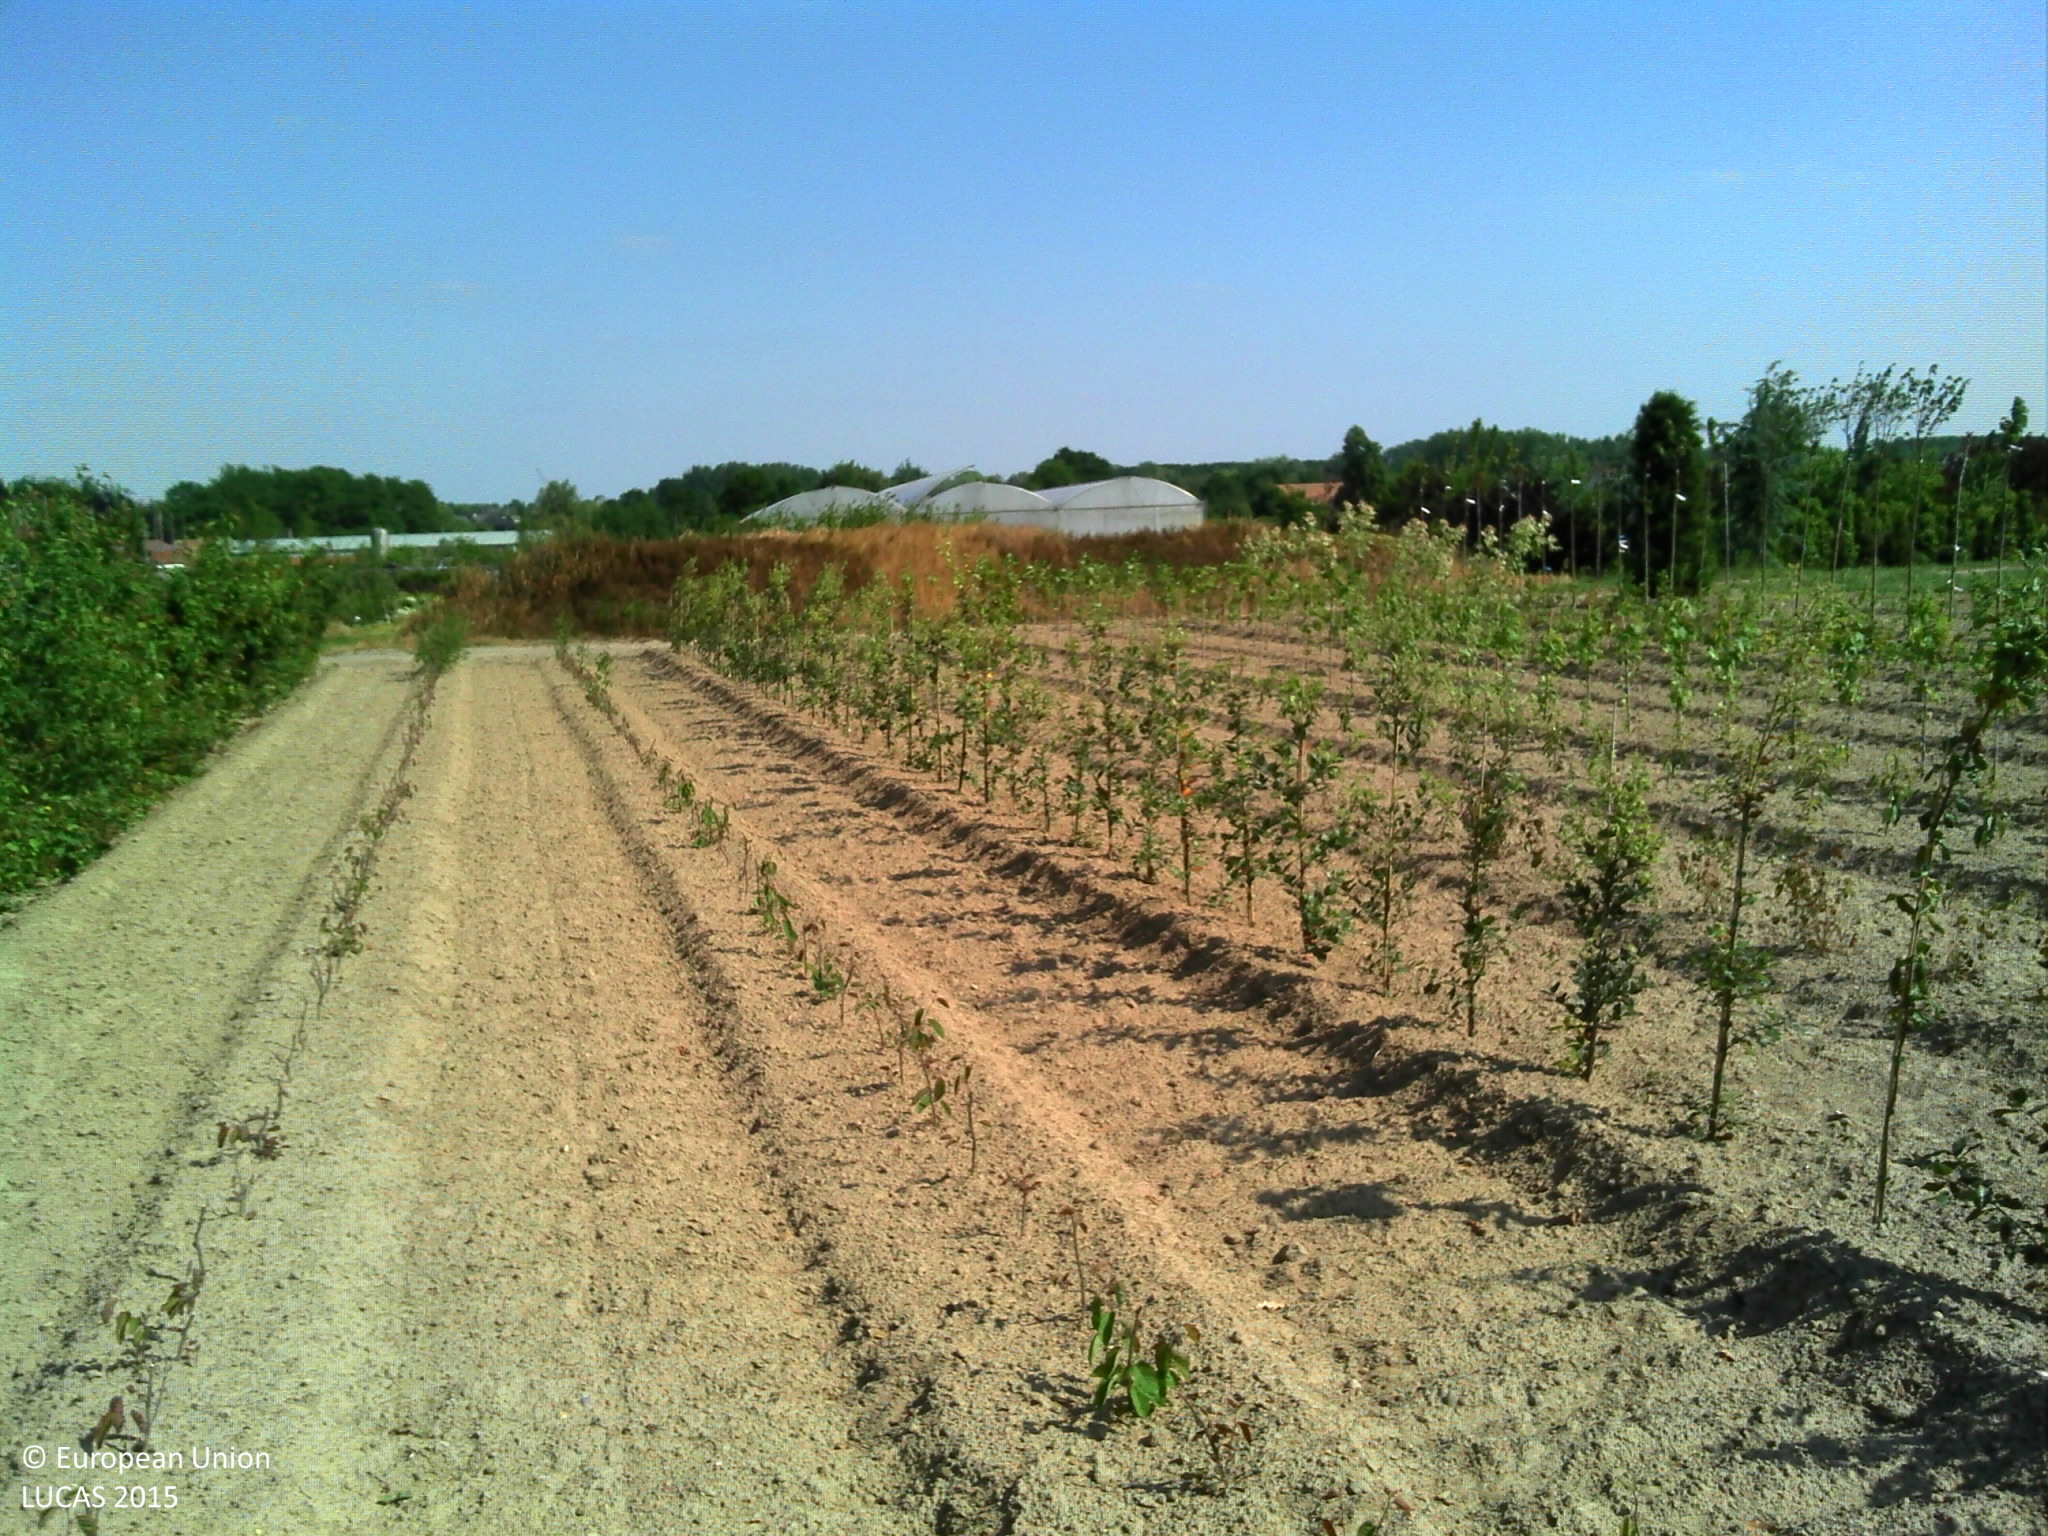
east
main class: Cropland
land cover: Nurseries
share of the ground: < 10 %
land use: Agriculture (excluding fallow land and kitchen gardens)
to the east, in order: Nurseries; Tracks; Spontaneously vegetated surfaces; Artificial constructions in urban areas; Grassland without tree/shrub cover; Grassland with sparse tree/shrub cover; Grassland without tree/shrub cover; Paved roads, cycling and walking lanes; Potatoes; Artificial constructions in urban areas
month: June
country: BE
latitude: 50.9952
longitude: 3.9098
